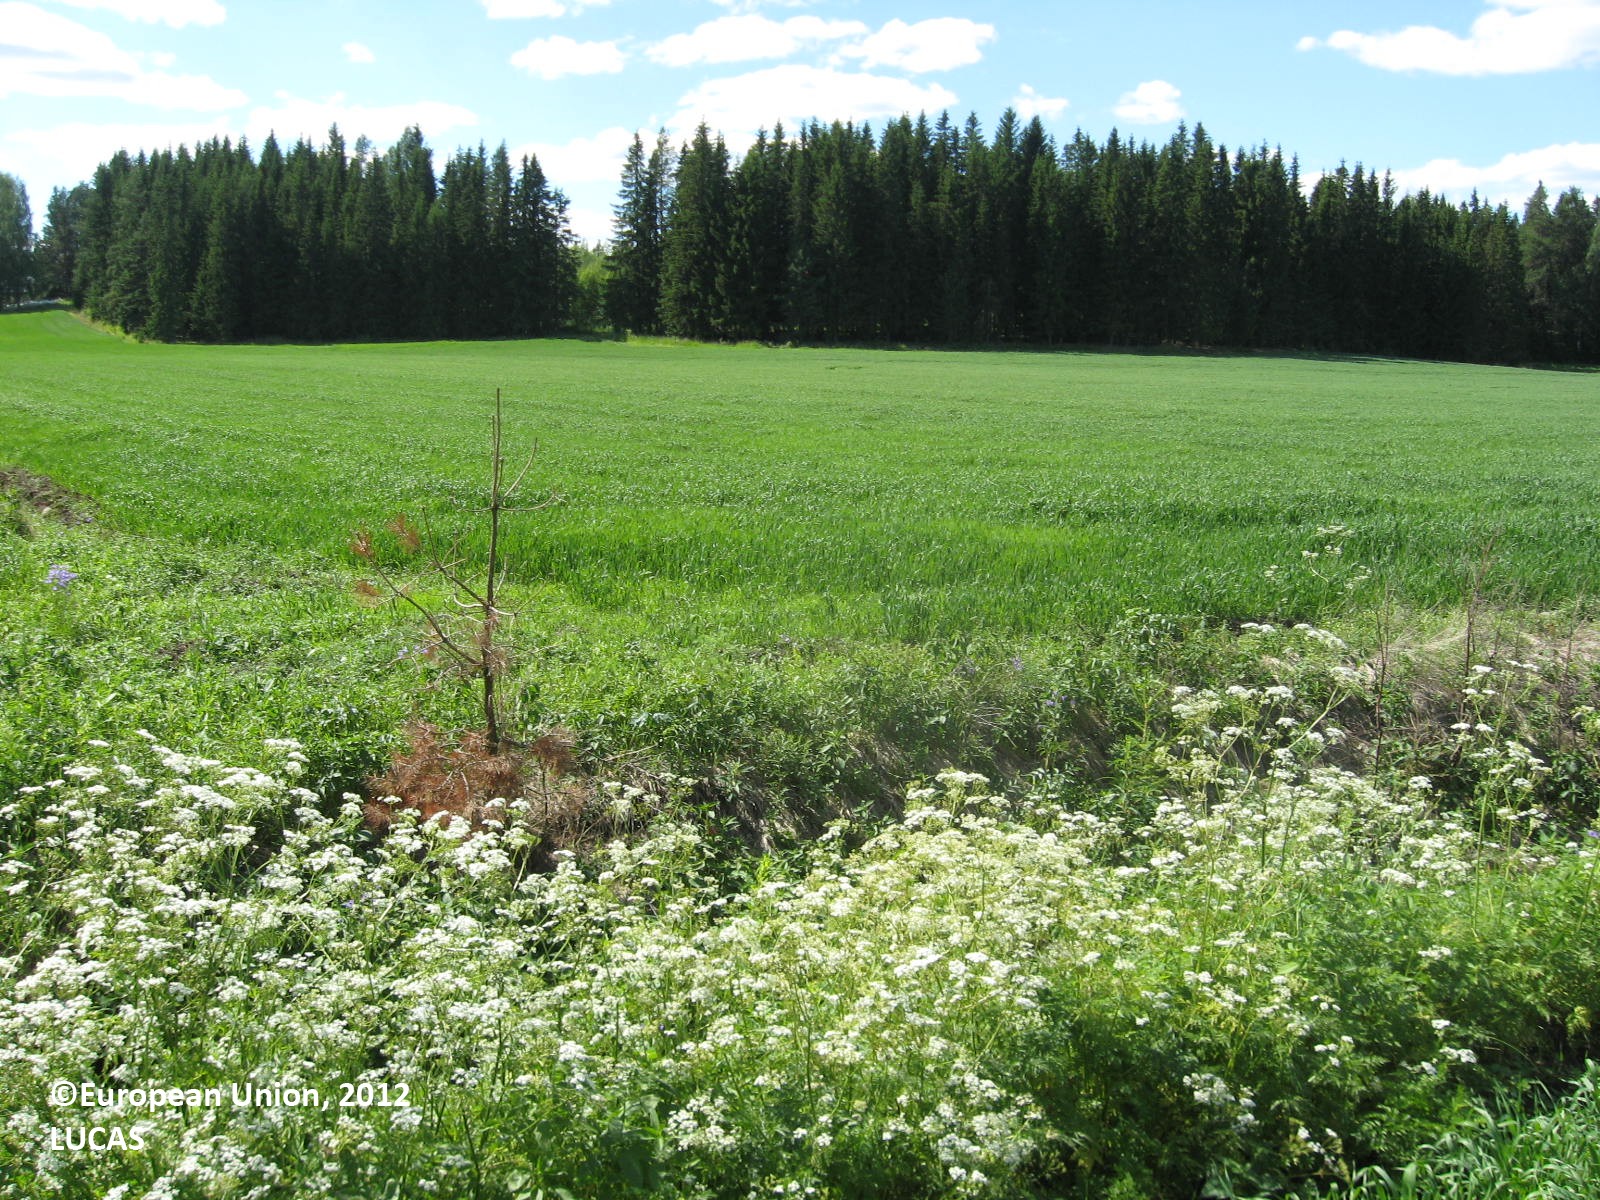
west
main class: Cropland
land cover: Barley
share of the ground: > 75 %
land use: Agriculture (excluding fallow land and kitchen gardens)
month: July
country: FI
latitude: 62.5401
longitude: 22.7919
